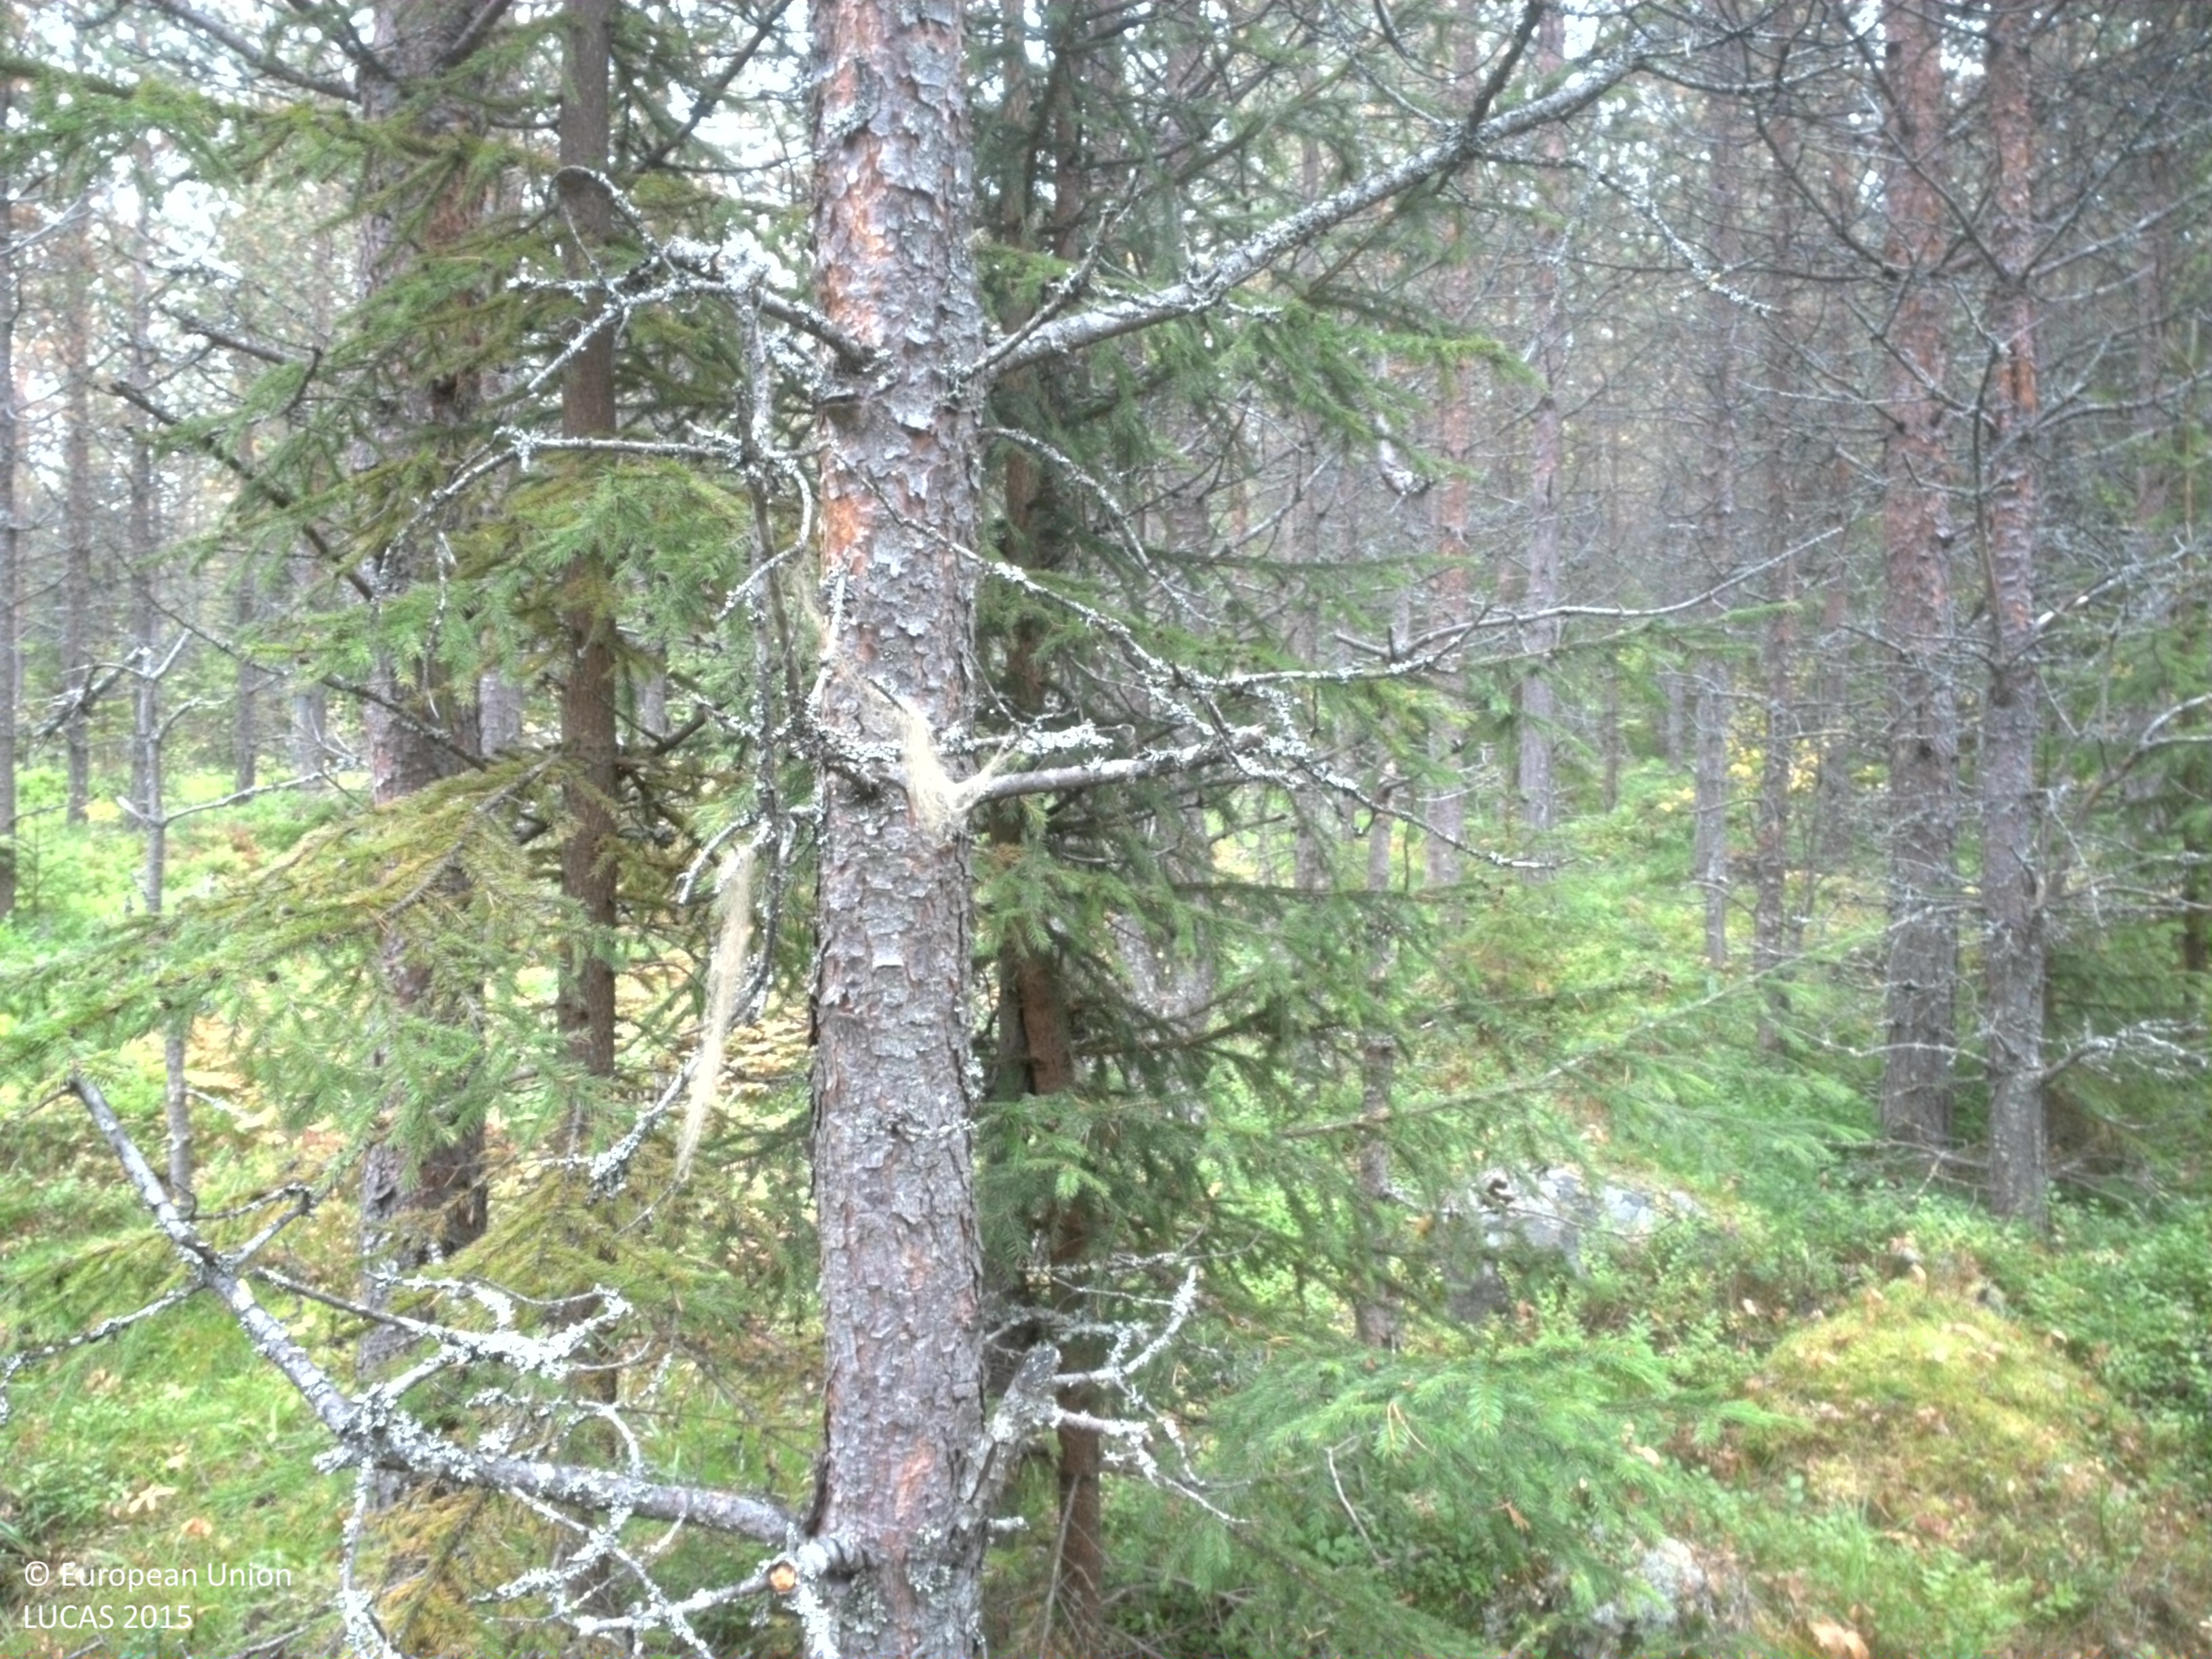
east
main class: Woodland
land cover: Pine dominated coniferous woodland
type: boreal forest
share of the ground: 50 - 75 %
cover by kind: coniferous forest trees 60 %, shrubs 20 %, herbaceous plants 10 %, broadleaved forest trees 5 %, lichens and mosses 5 %
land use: Forestry
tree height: > 5 m
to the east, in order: Pine dominated coniferous woodland
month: September
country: SE
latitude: 64.4302
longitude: 20.2552
